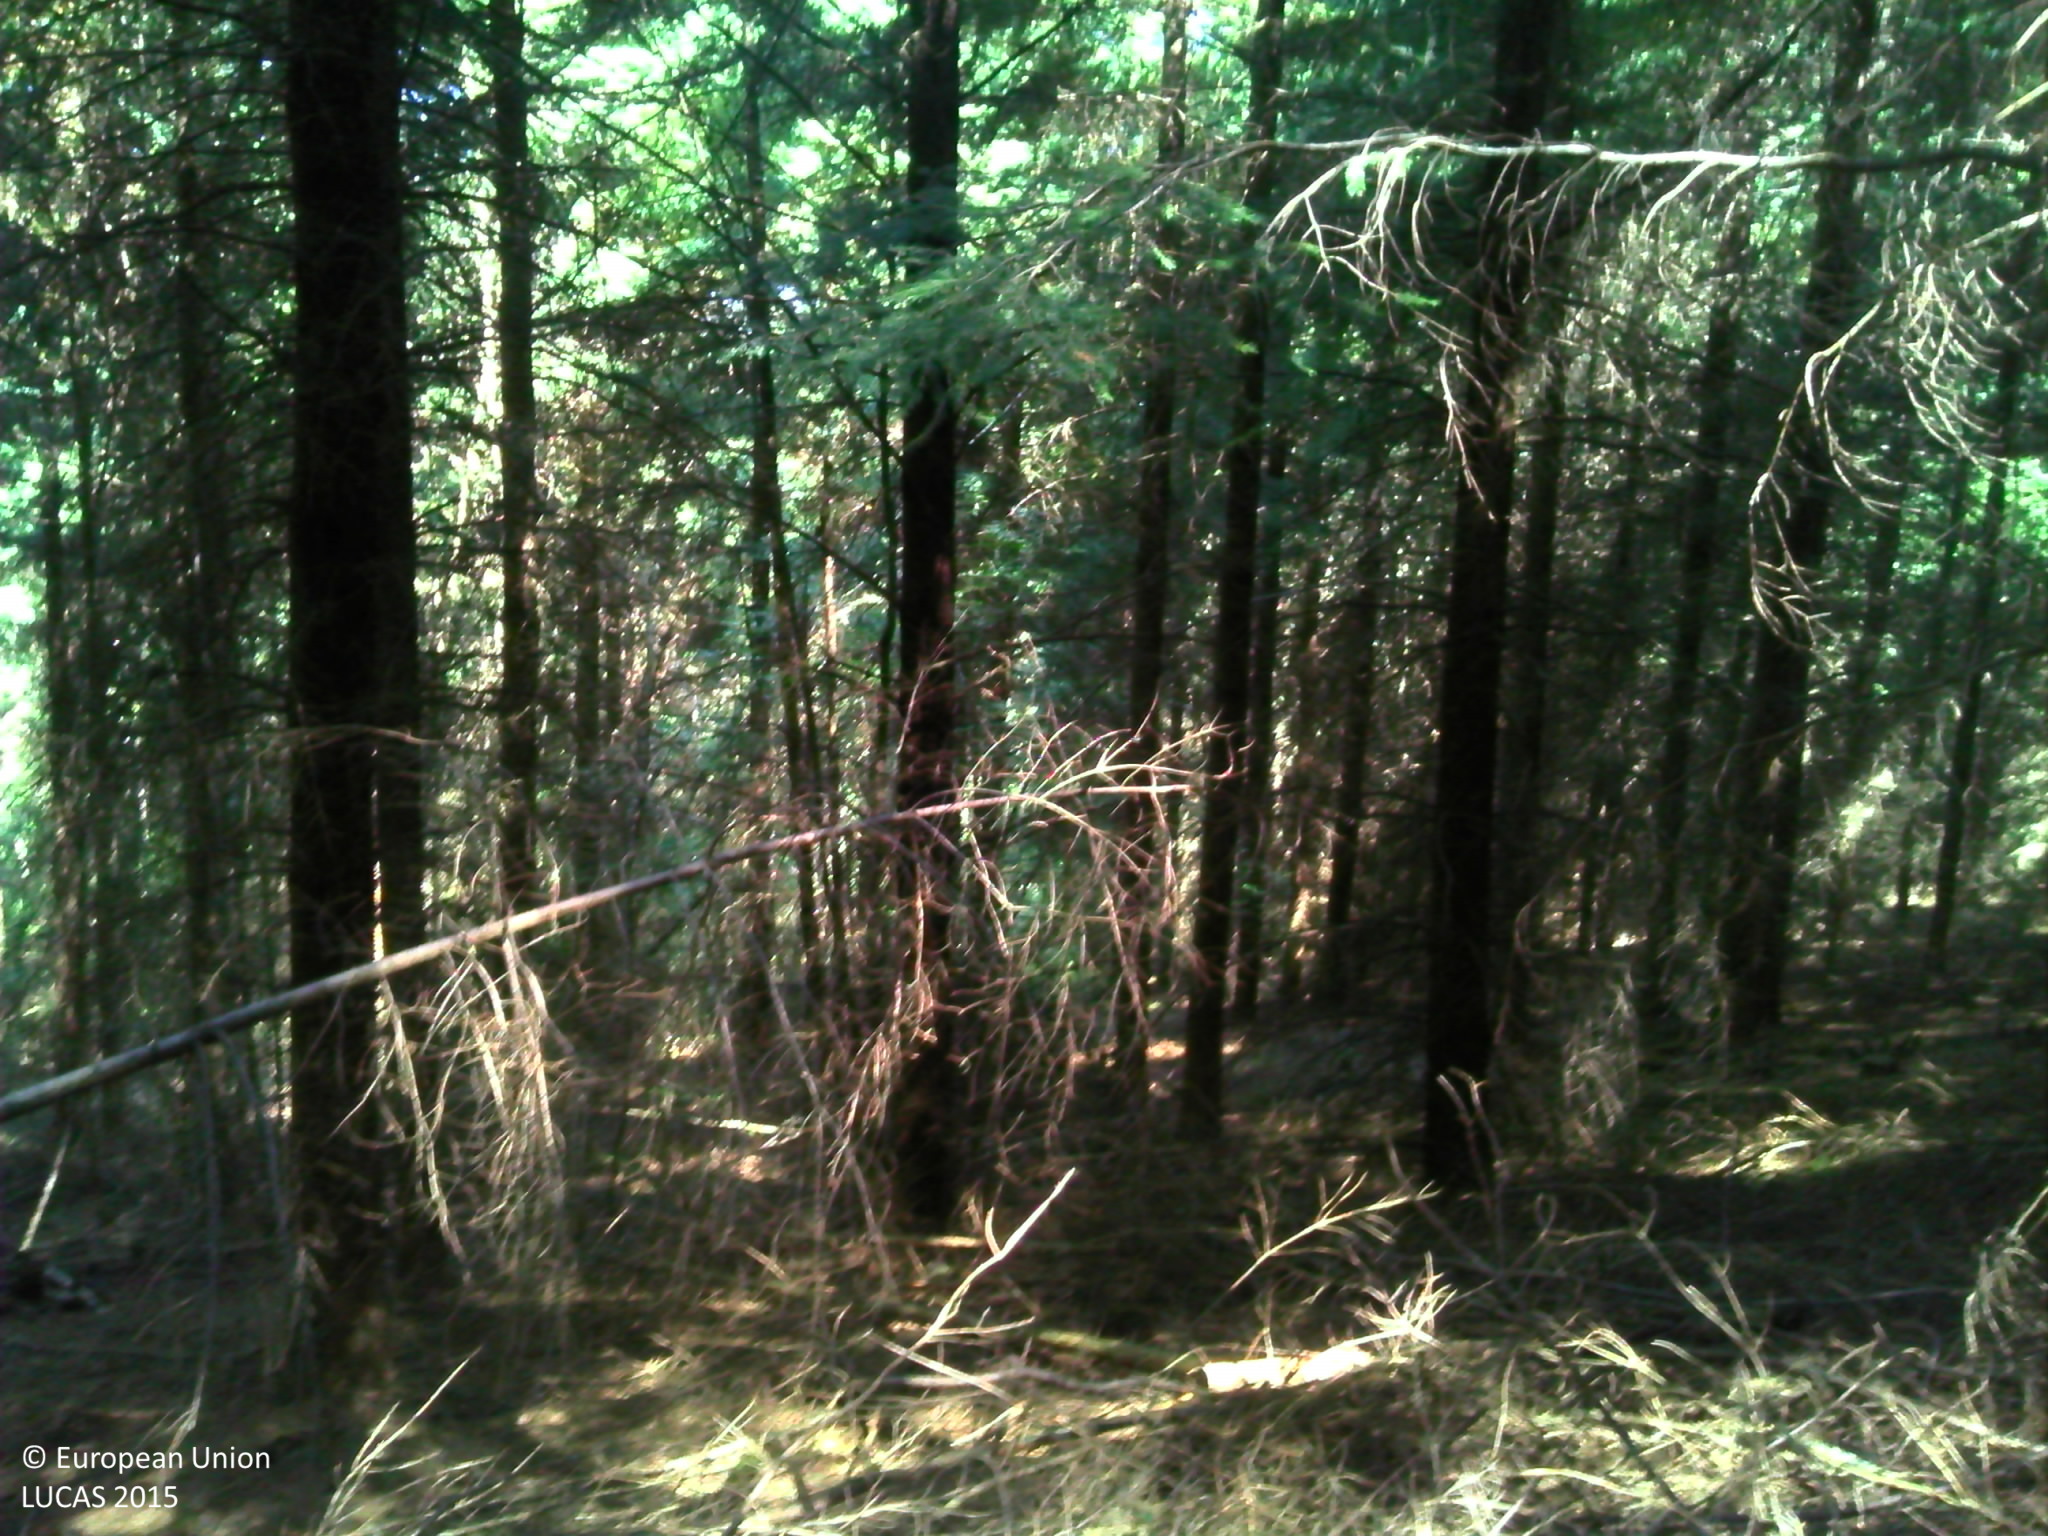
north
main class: Woodland
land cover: Spruce dominated coniferous woodland
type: hemiboreal forest and nemoral coniferous forest and mixed broadleaved-coniferous forest
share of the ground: > 75 %
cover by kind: coniferous forest trees 80 %, herbaceous plants 20 %
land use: Forestry
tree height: > 5 m
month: August
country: FR
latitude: 45.7078
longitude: 4.5699
